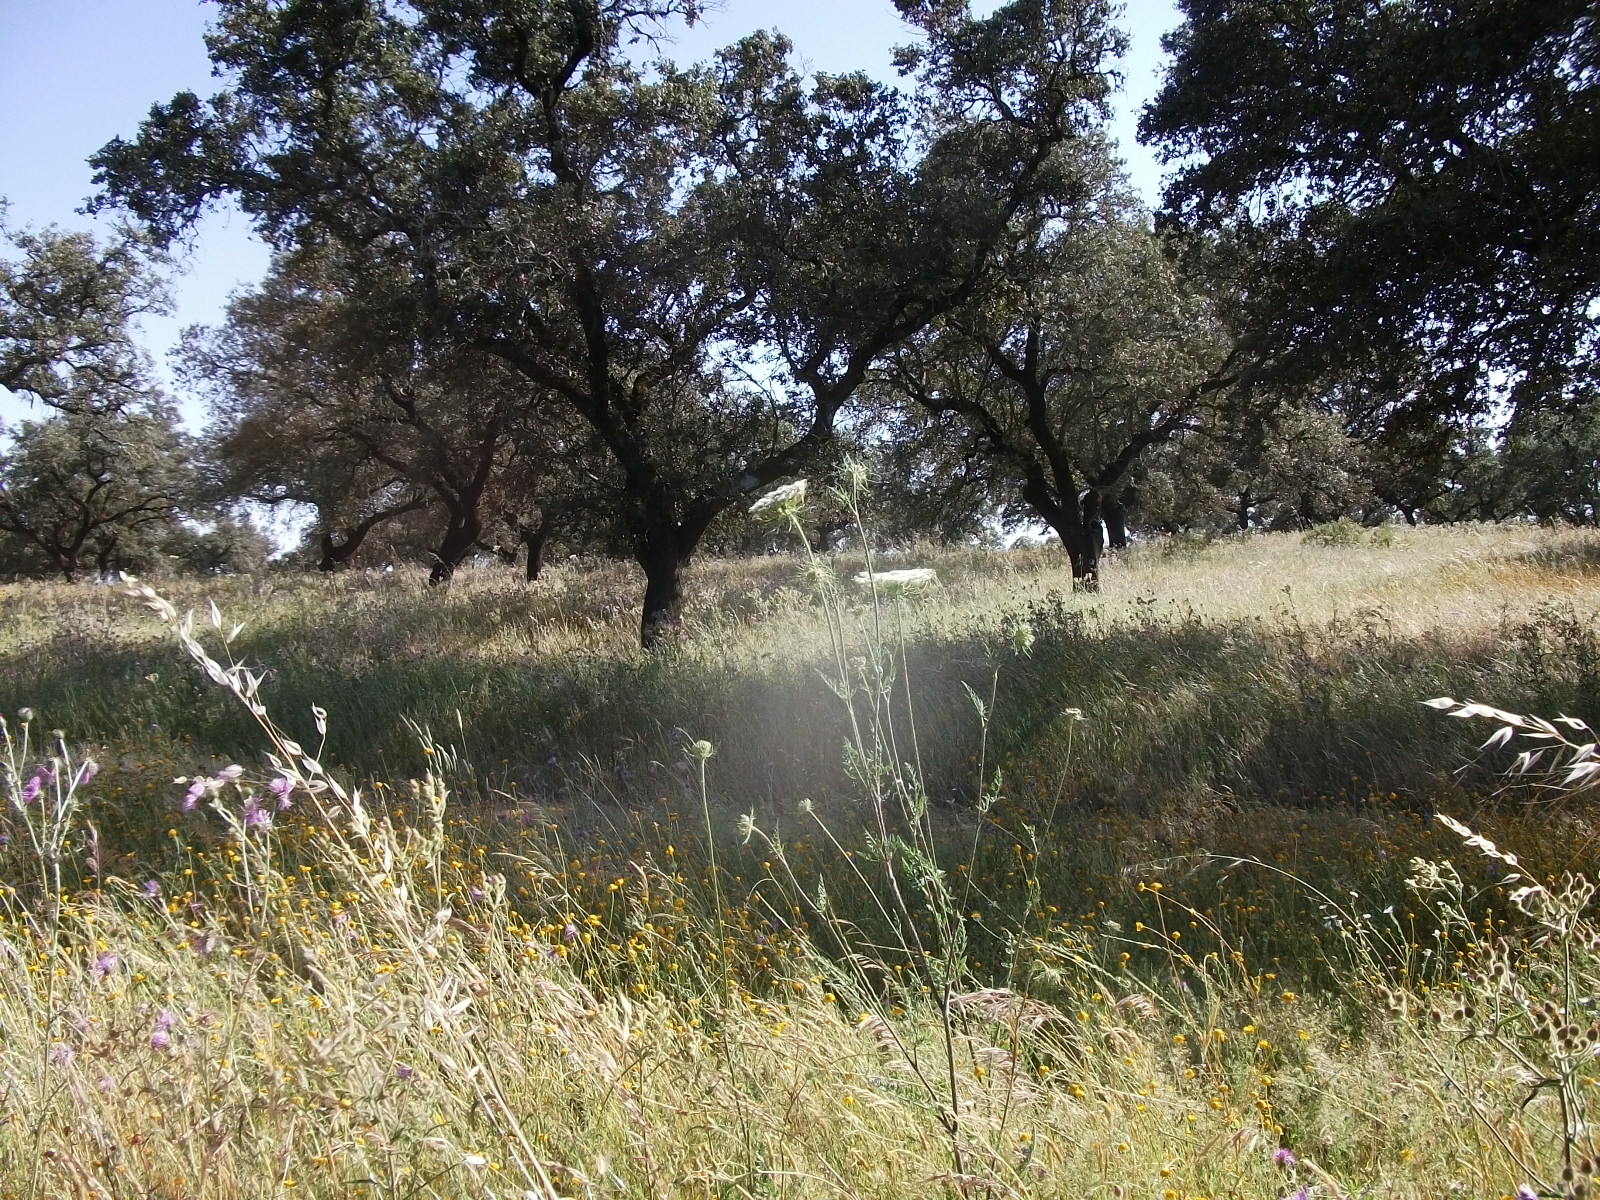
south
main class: Woodland
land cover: Broadleaved woodland
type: broadleaved evergreen forest
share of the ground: 25 - 50 %
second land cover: Spontaneously vegetated surfaces
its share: 50 - 75 %
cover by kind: herbaceous plants 60 %, broadleaved forest trees 40 %
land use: Forestry
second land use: Agriculture (excluding fallow land and kitchen gardens)
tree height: > 5 m
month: May
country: ES
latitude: 37.7683
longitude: -7.1375
